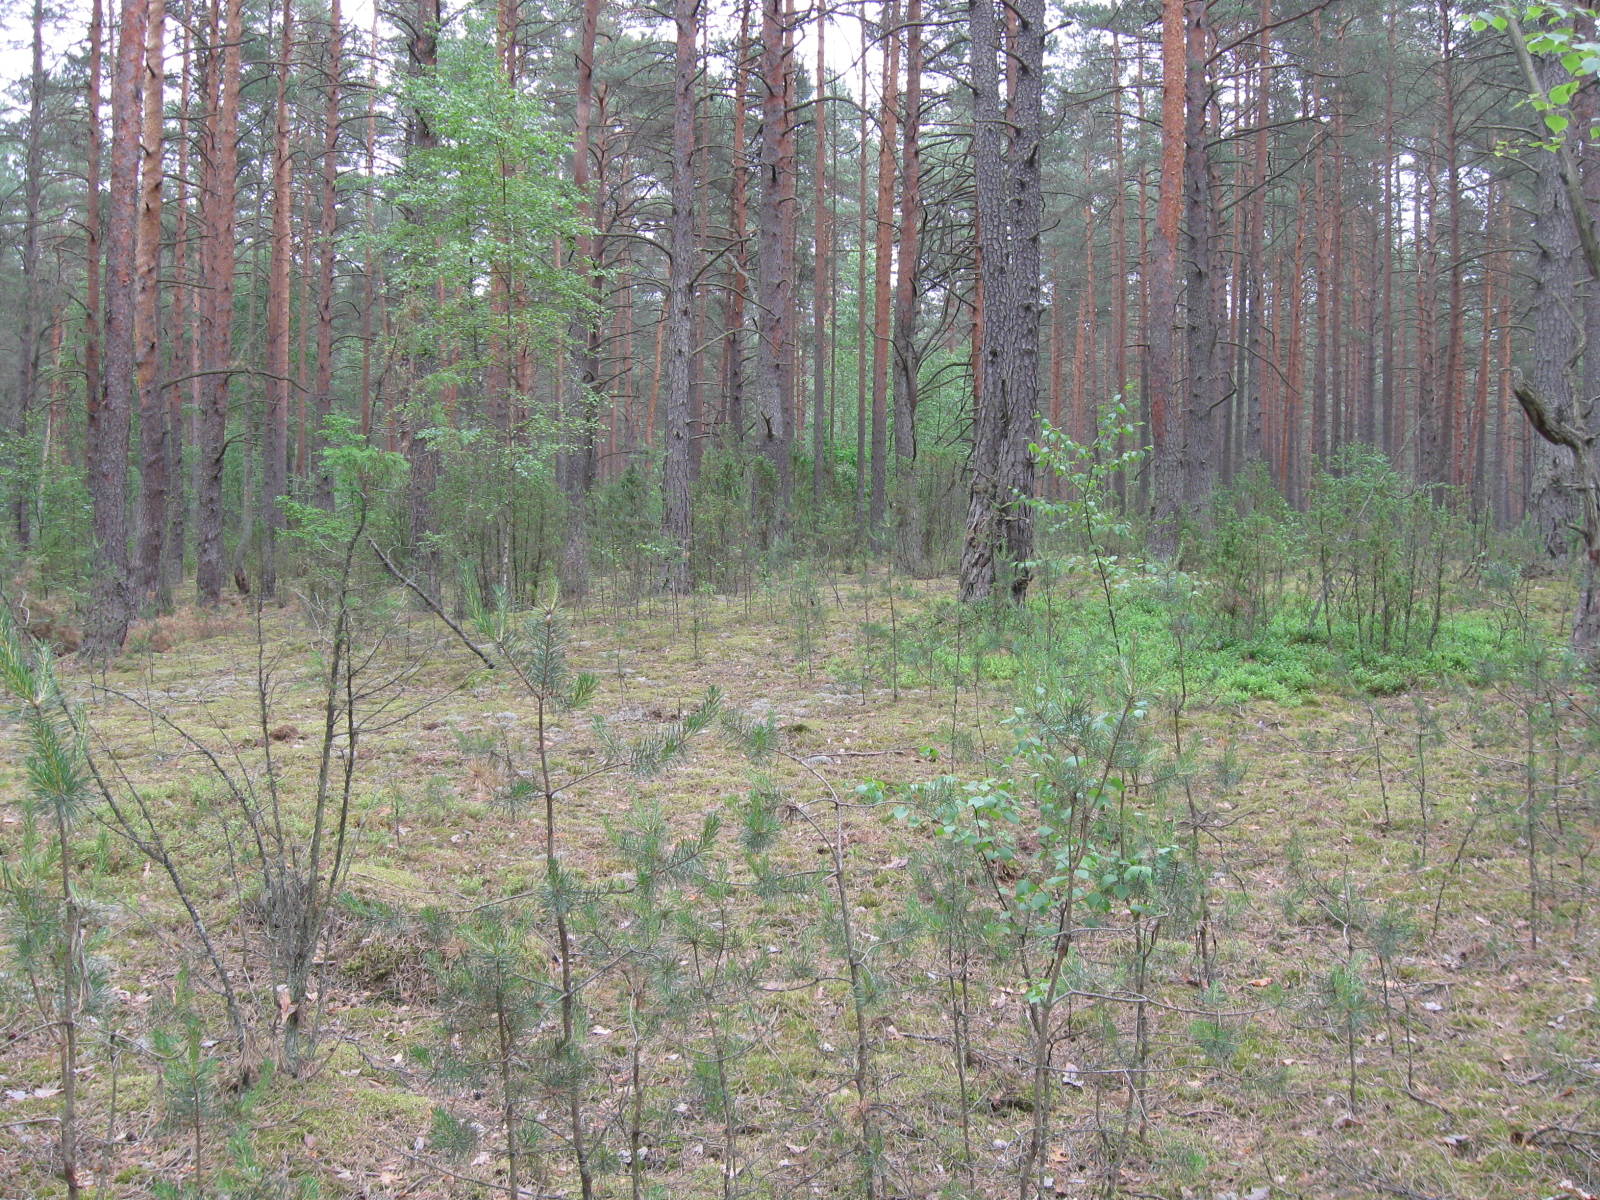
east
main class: Woodland
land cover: Pine dominated coniferous woodland
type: hemiboreal forest and nemoral coniferous forest and mixed broadleaved-coniferous forest
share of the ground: > 75 %
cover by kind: coniferous forest trees 80 %, broadleaved forest trees 15 %, lichens and mosses 5 %
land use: Forestry
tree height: > 5 m
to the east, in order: Pine dominated coniferous woodland; Pine dominated mixed woodland
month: July
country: LT
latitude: 54.1212
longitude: 24.2822
